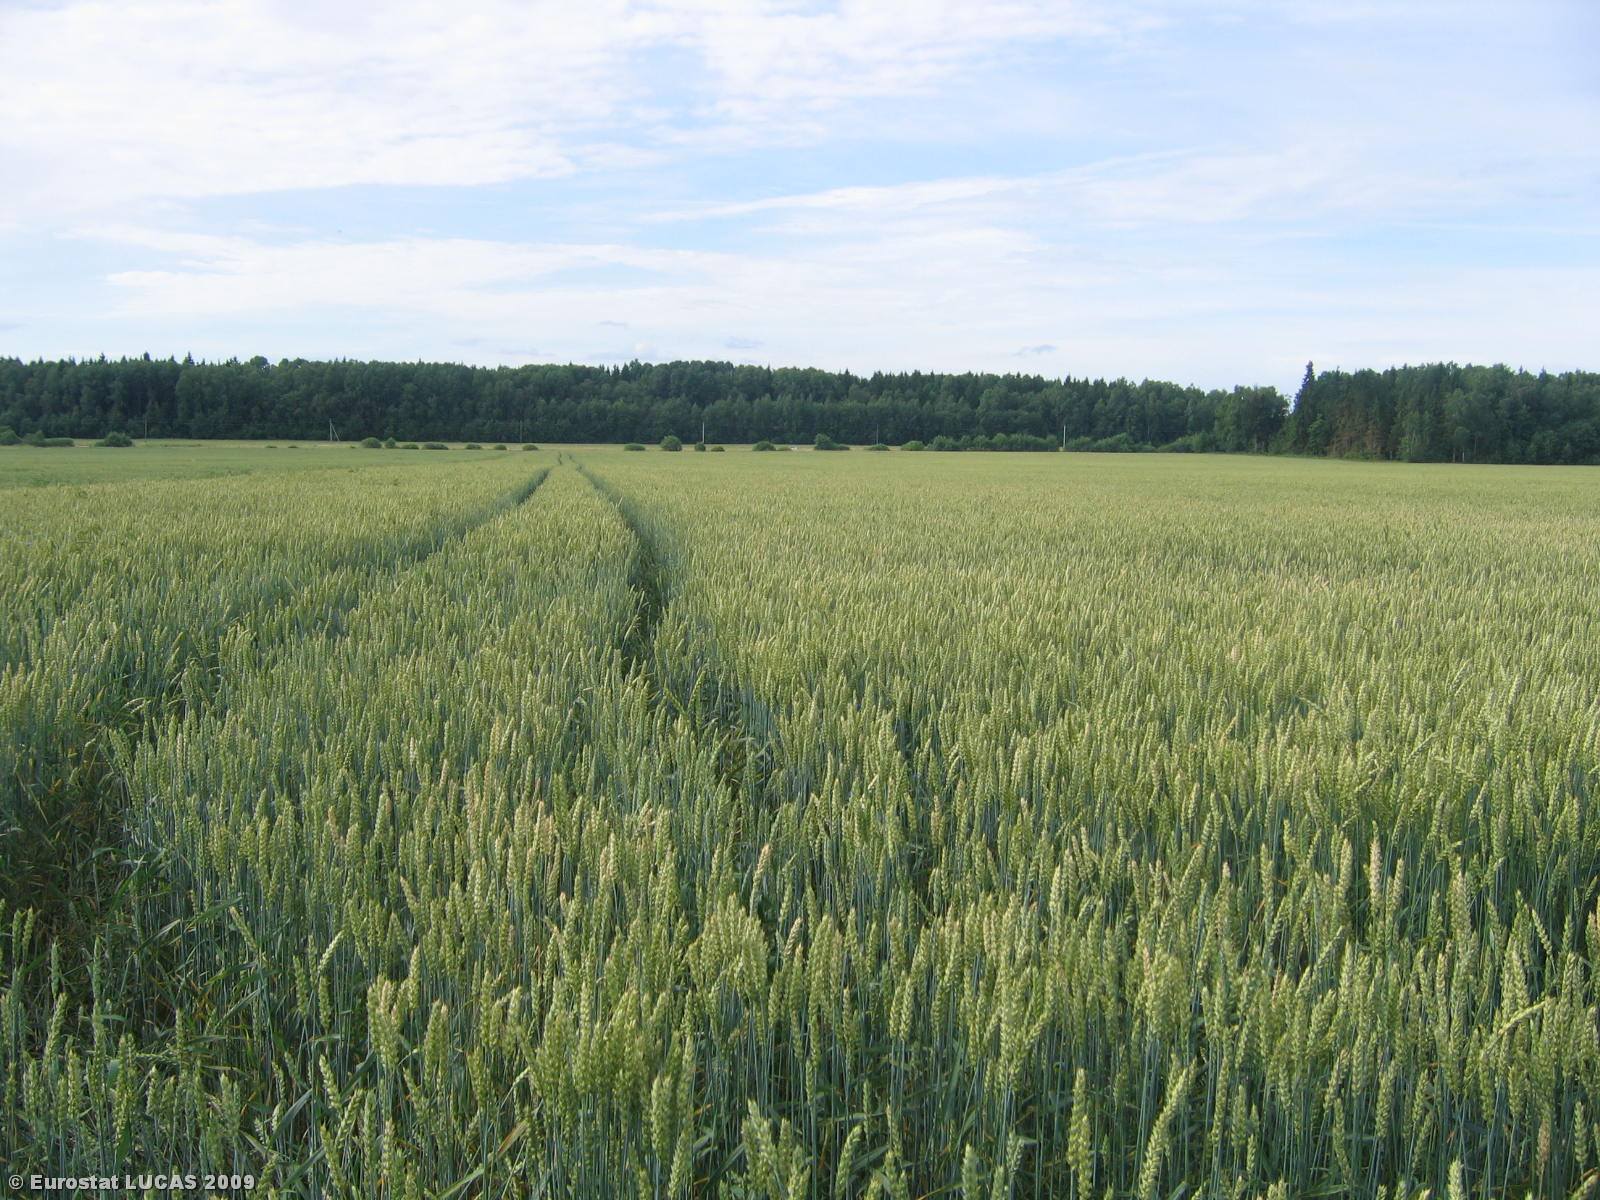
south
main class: Cropland
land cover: Common wheat
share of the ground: > 75 %
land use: Agriculture (excluding fallow land and kitchen gardens)
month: July
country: LT
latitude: 55.3740
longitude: 22.6728
